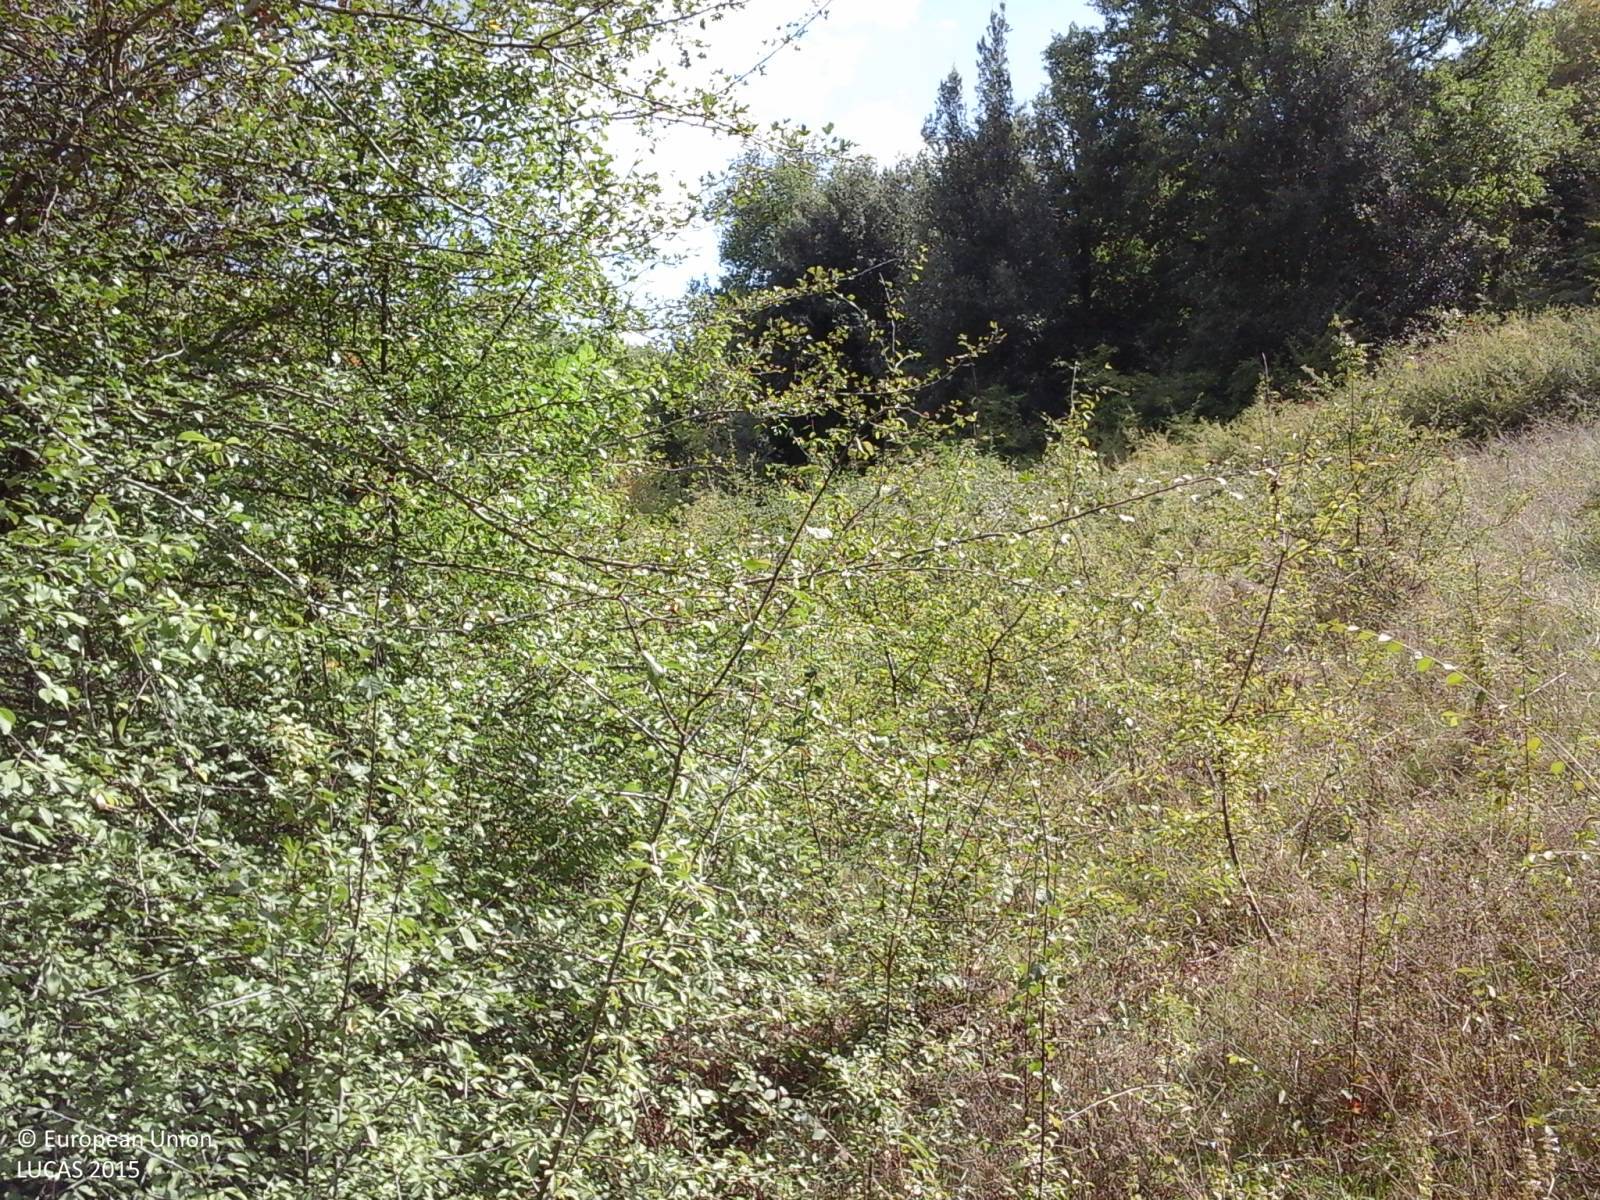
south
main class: Shrubland
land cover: Shrubland with sparse tree cover
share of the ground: > 75 %
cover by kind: shrubs 95 %, broadleaved forest trees 5 %
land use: Abandoned areas
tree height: < 5 m
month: September
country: IT
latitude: 42.3857
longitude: 12.6027
